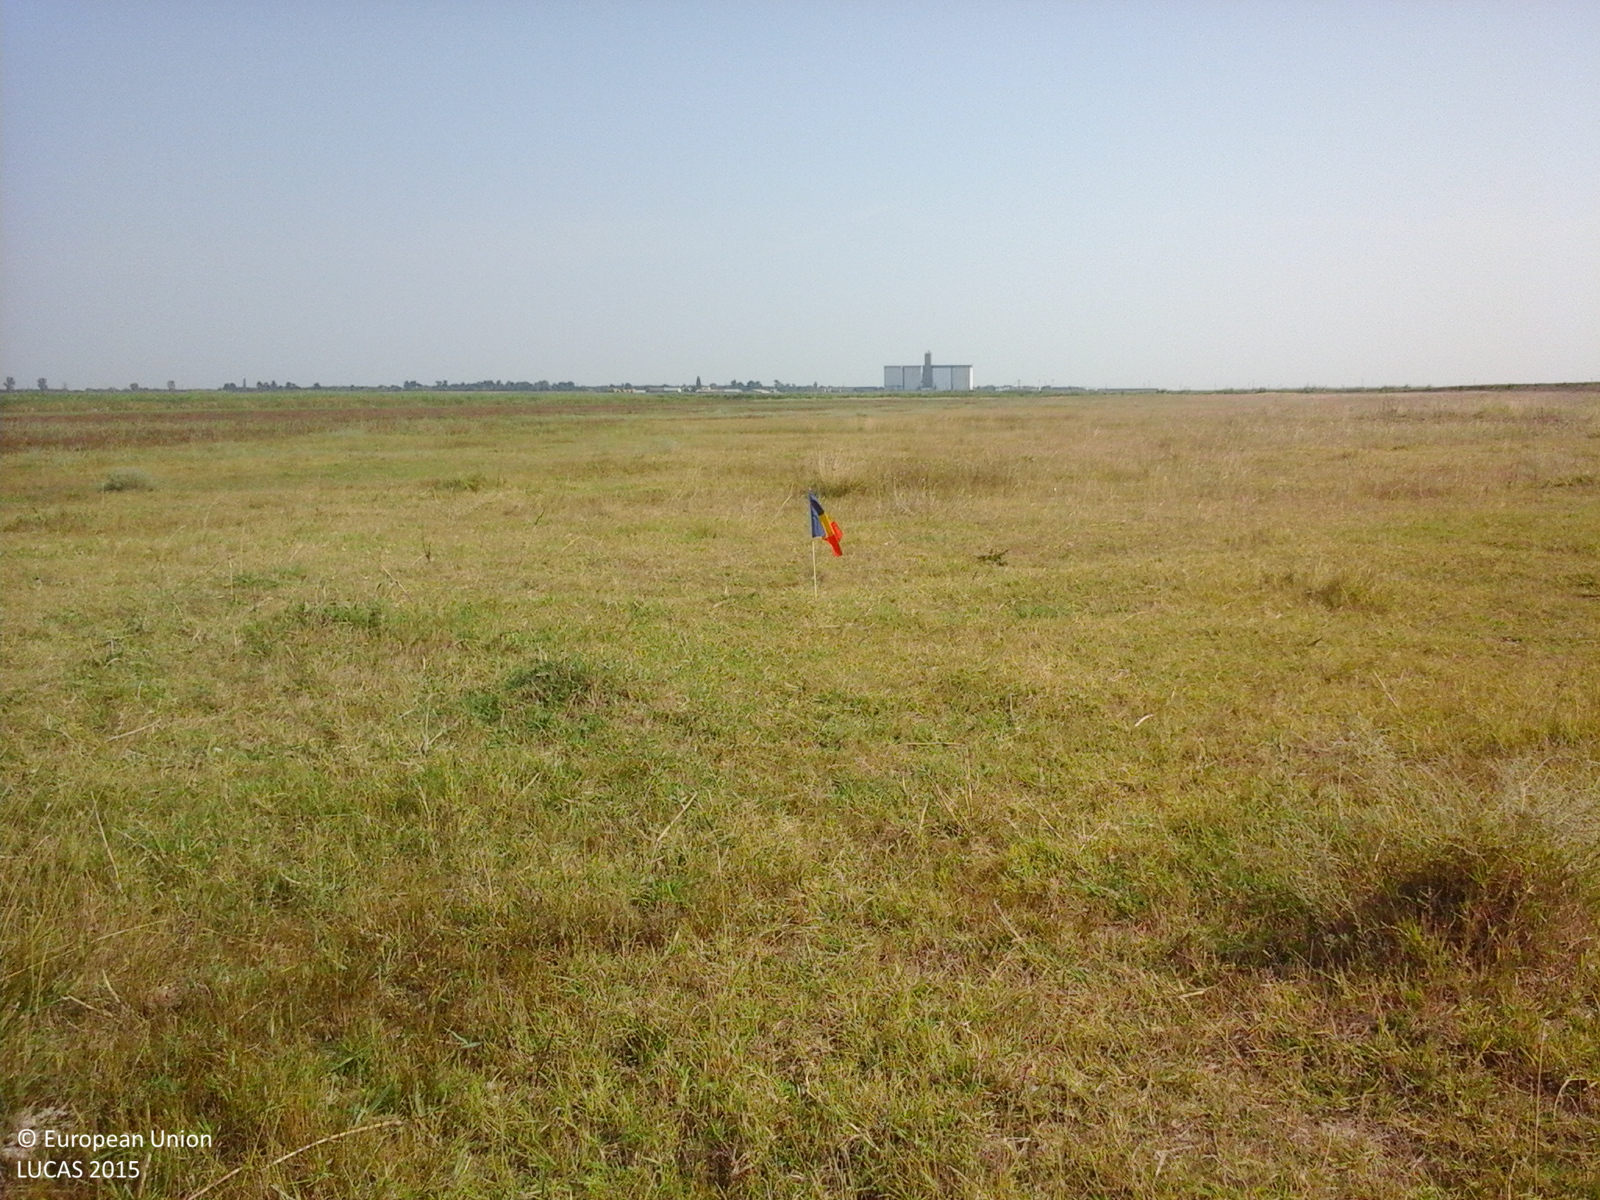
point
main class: Grassland
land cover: Grassland without tree/shrub cover
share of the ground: > 75 %
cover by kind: herbaceous plants 100 %
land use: Agriculture (excluding fallow land and kitchen gardens)
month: August
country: RO
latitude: 45.2074
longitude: 27.7142
